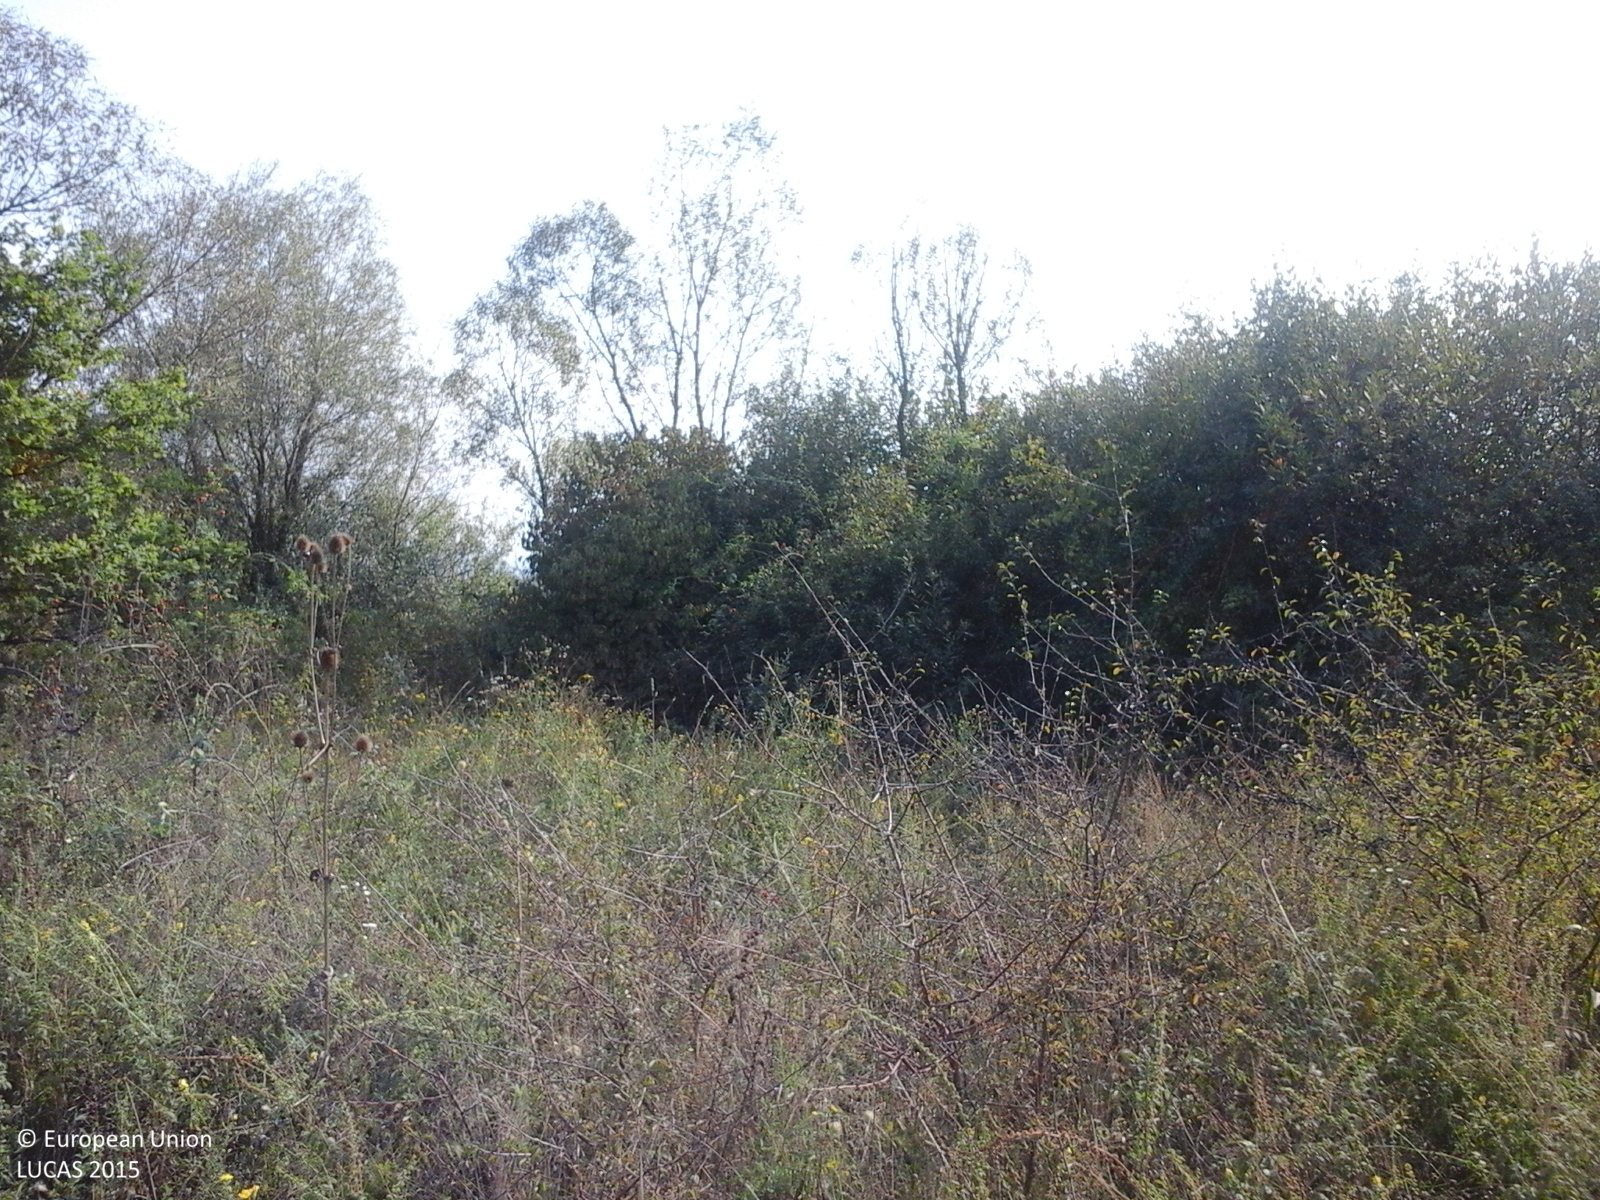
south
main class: Grassland
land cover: Spontaneously vegetated surfaces
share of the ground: > 75 %
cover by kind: herbaceous plants 100 %
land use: Fallow land
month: September
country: RO
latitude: 45.8398
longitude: 22.2889
